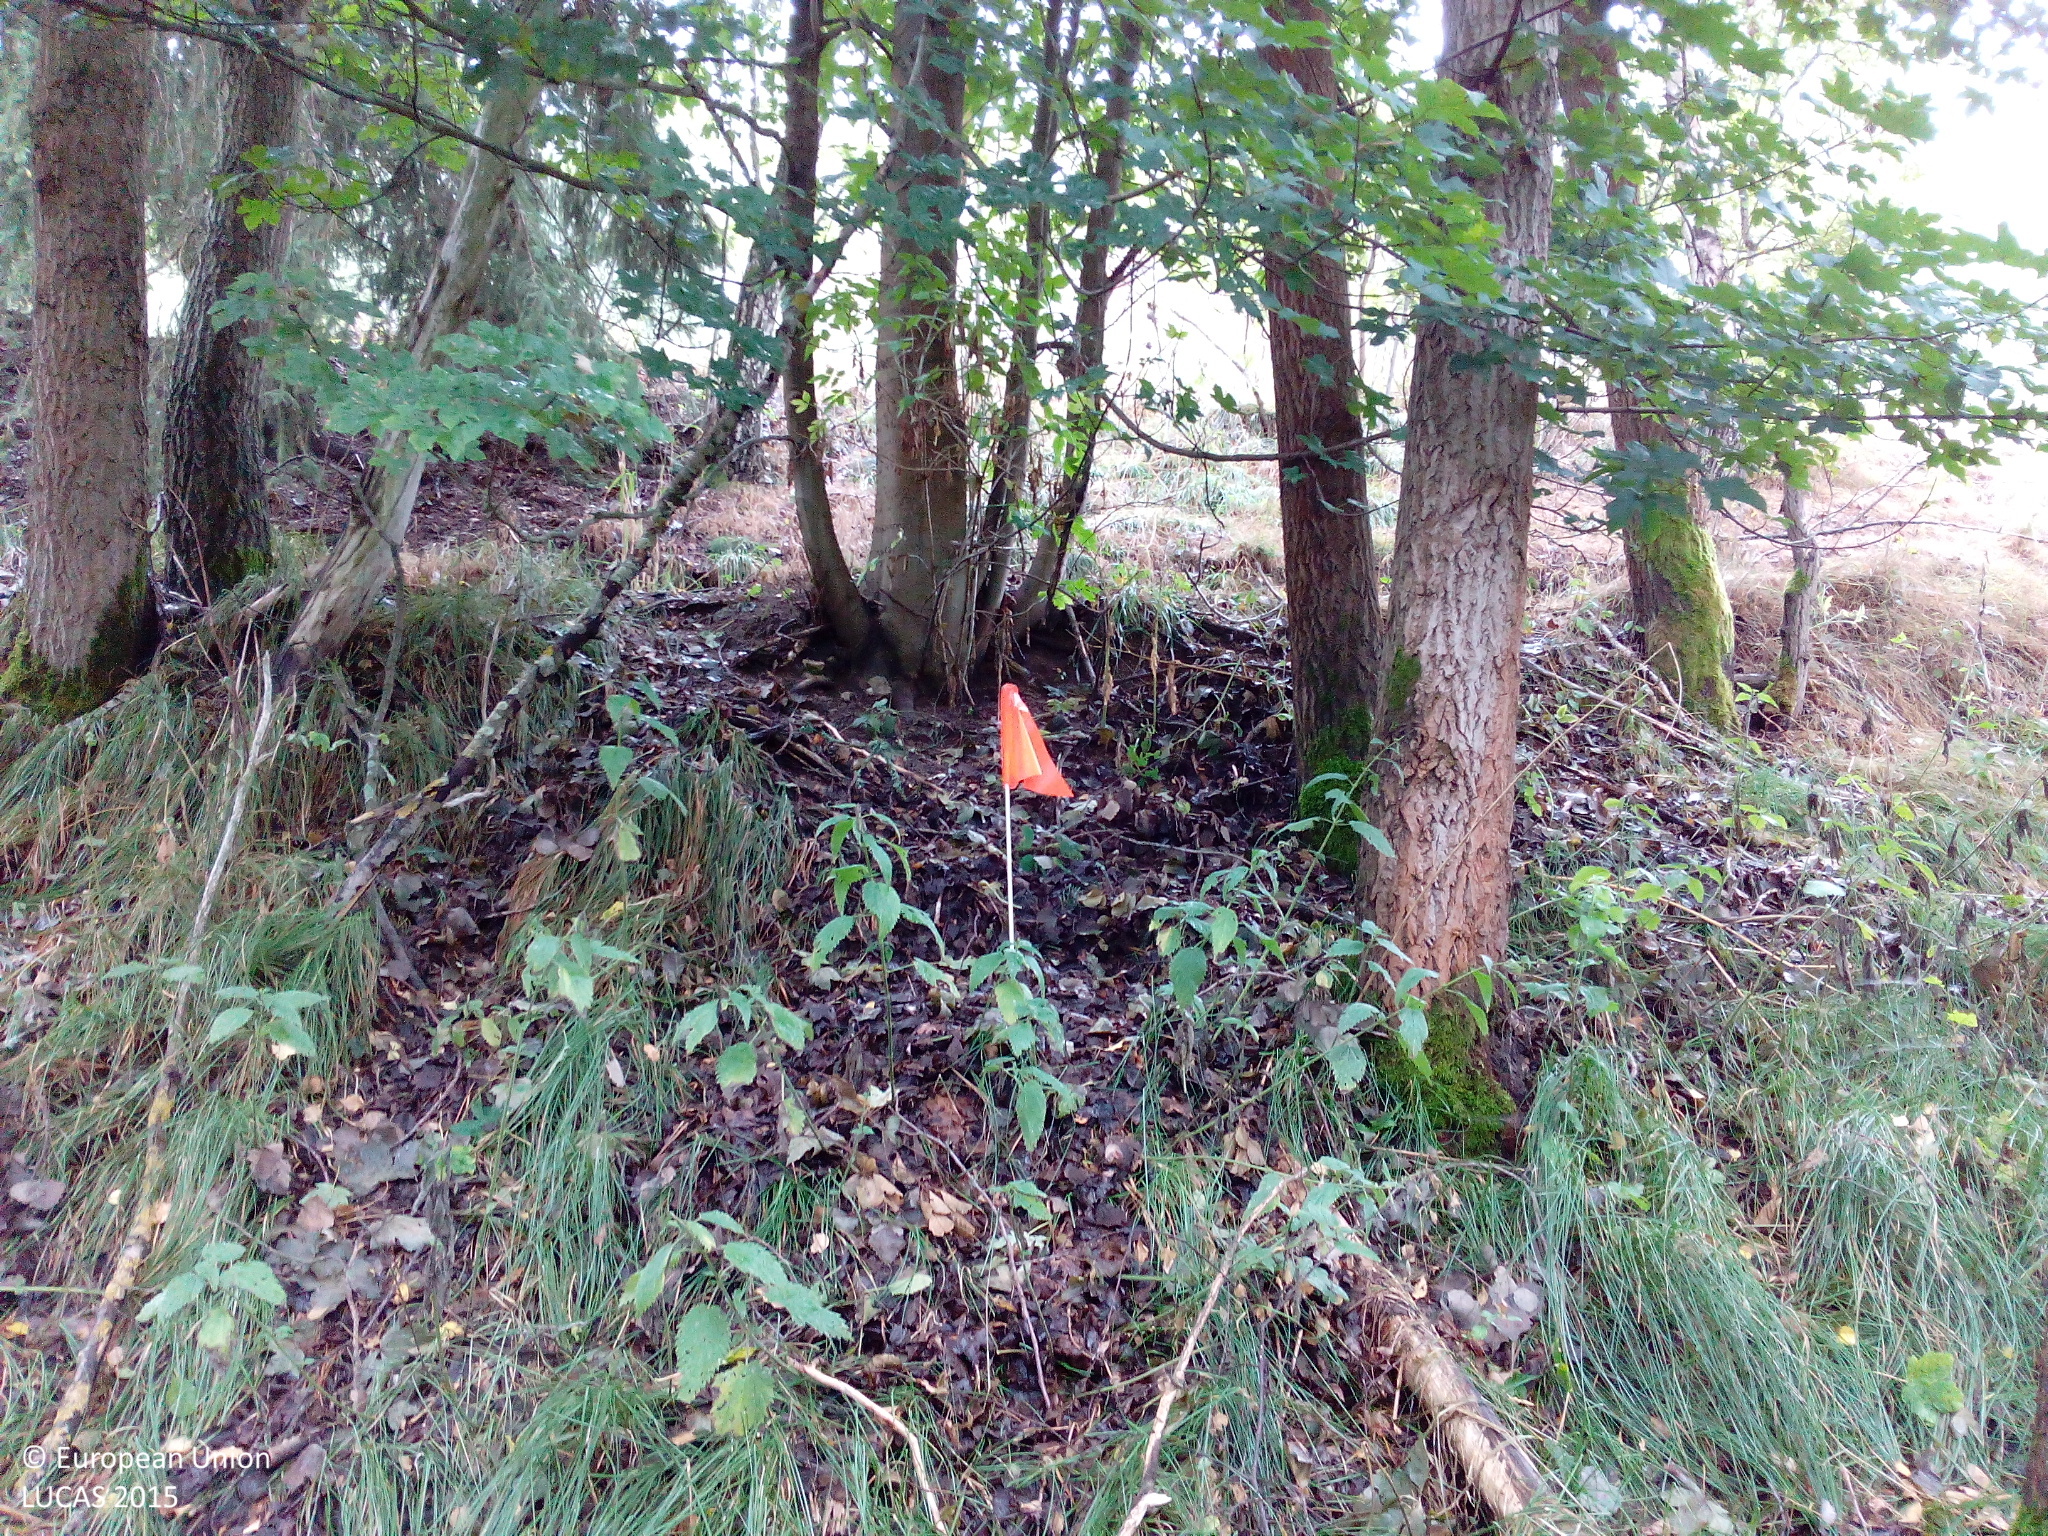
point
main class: Woodland
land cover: Broadleaved woodland
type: floodplain forest
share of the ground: > 75 %
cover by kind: broadleaved forest trees 90 %, herbaceous plants 10 %
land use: Semi-natural and natural areas not in use
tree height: > 5 m
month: August
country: DE
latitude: 50.1292
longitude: 12.0839
